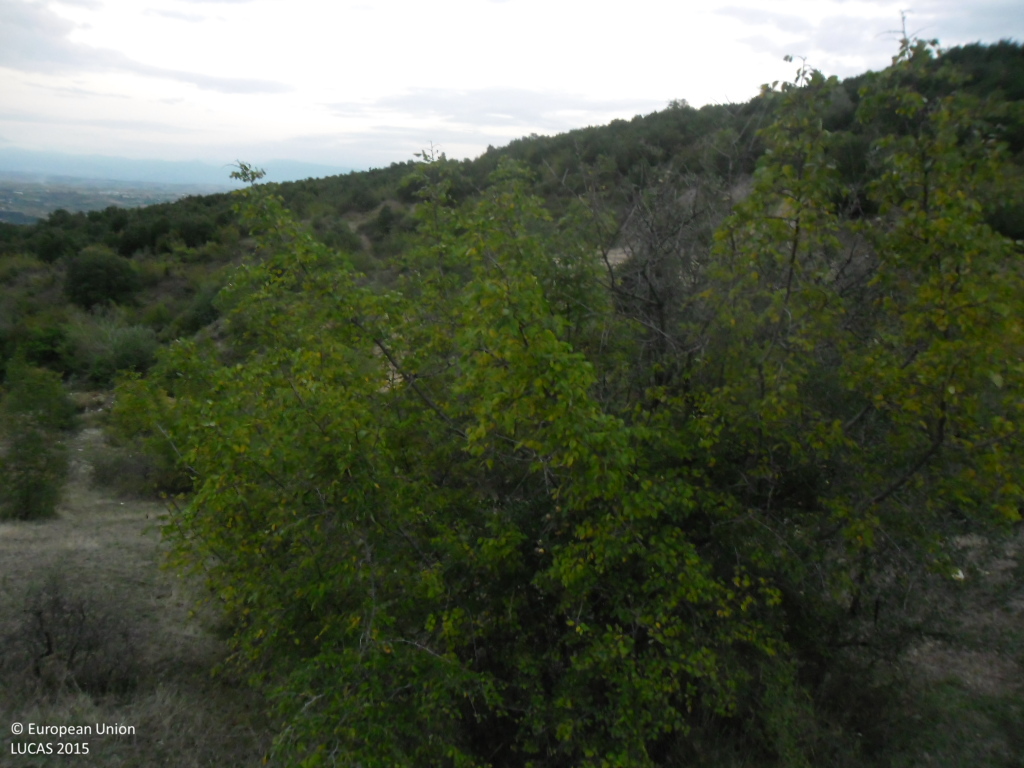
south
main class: Grassland
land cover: Grassland with sparse tree/shrub cover
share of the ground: > 75 %
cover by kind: herbaceous plants 90 %, broadleaved forest trees 5 %, shrubs 5 %
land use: Agriculture (excluding fallow land and kitchen gardens)
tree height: < 5 m
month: September
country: BG
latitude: 41.5844
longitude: 23.2036
